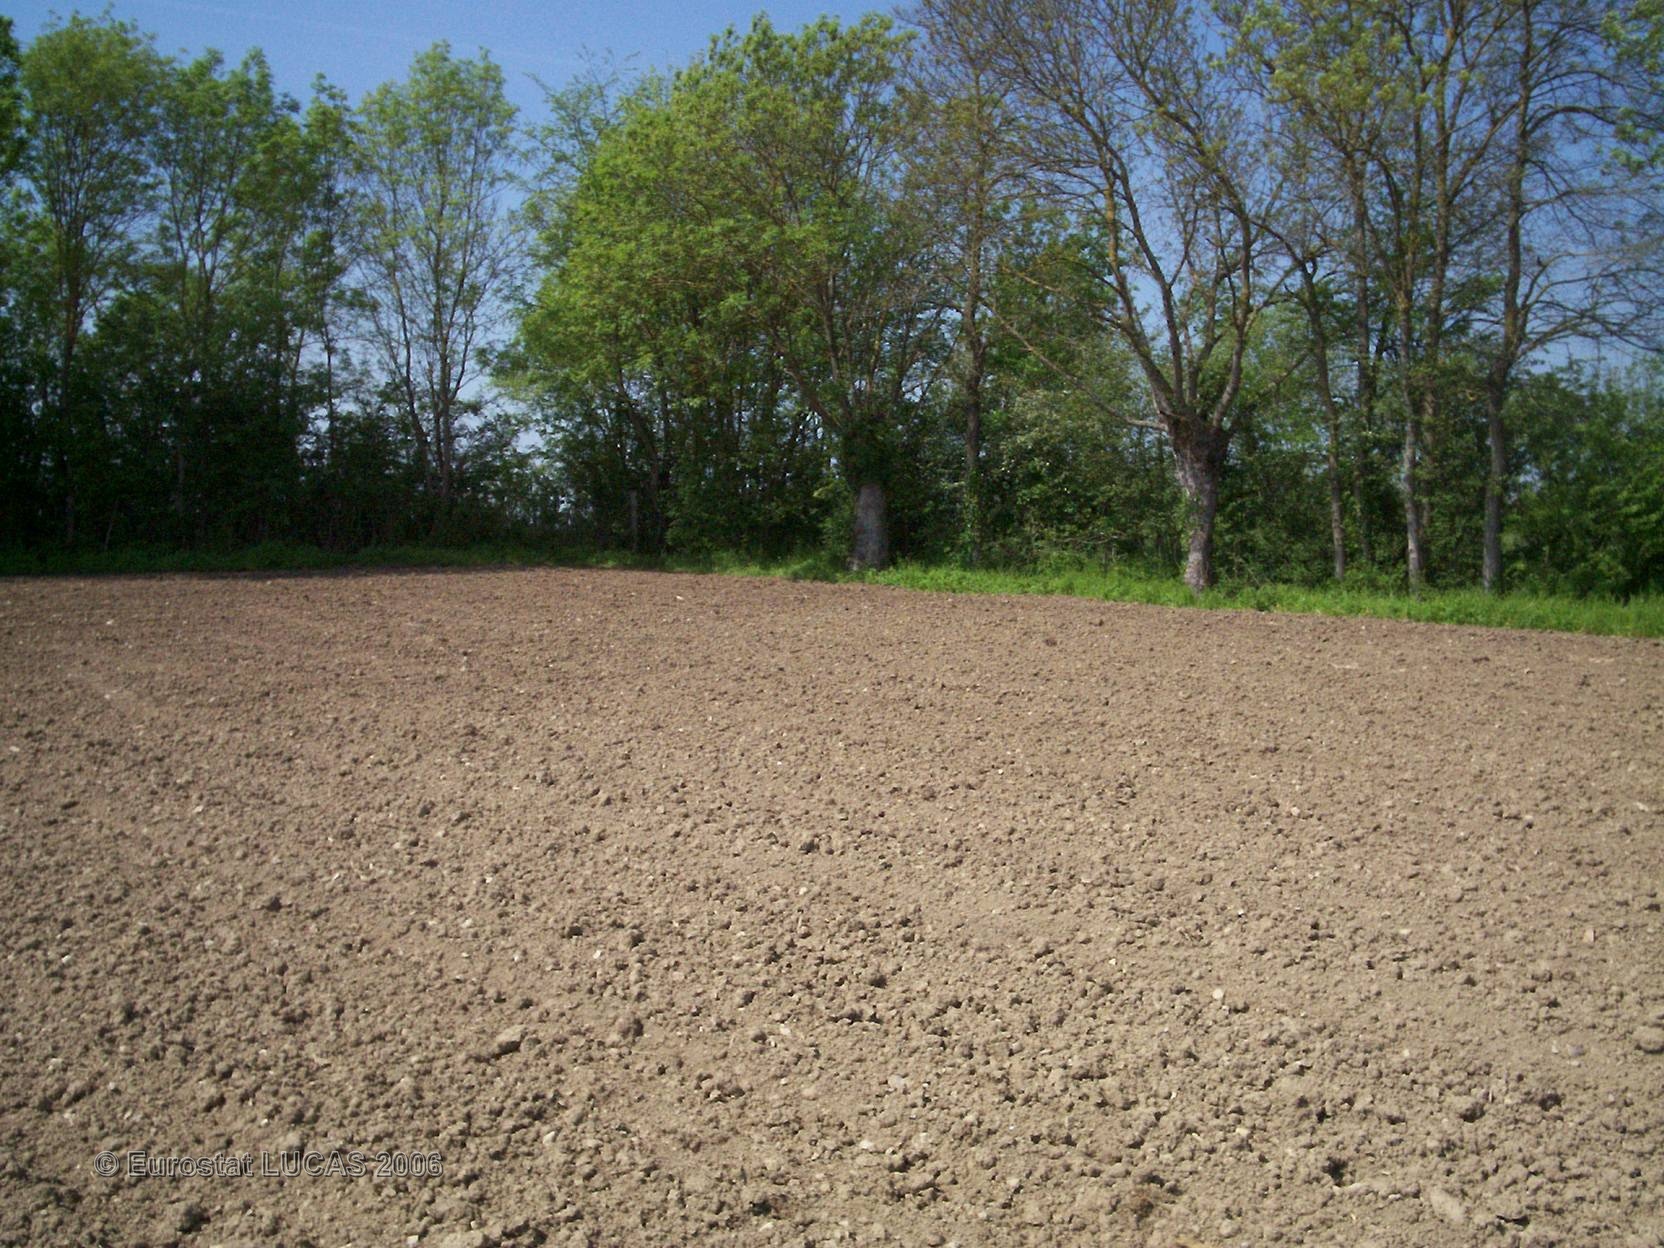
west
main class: Cropland
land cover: Maize
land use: Agriculture (excluding fallow land and kitchen gardens)
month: May
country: FR
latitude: 46.1491
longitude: -0.2377
